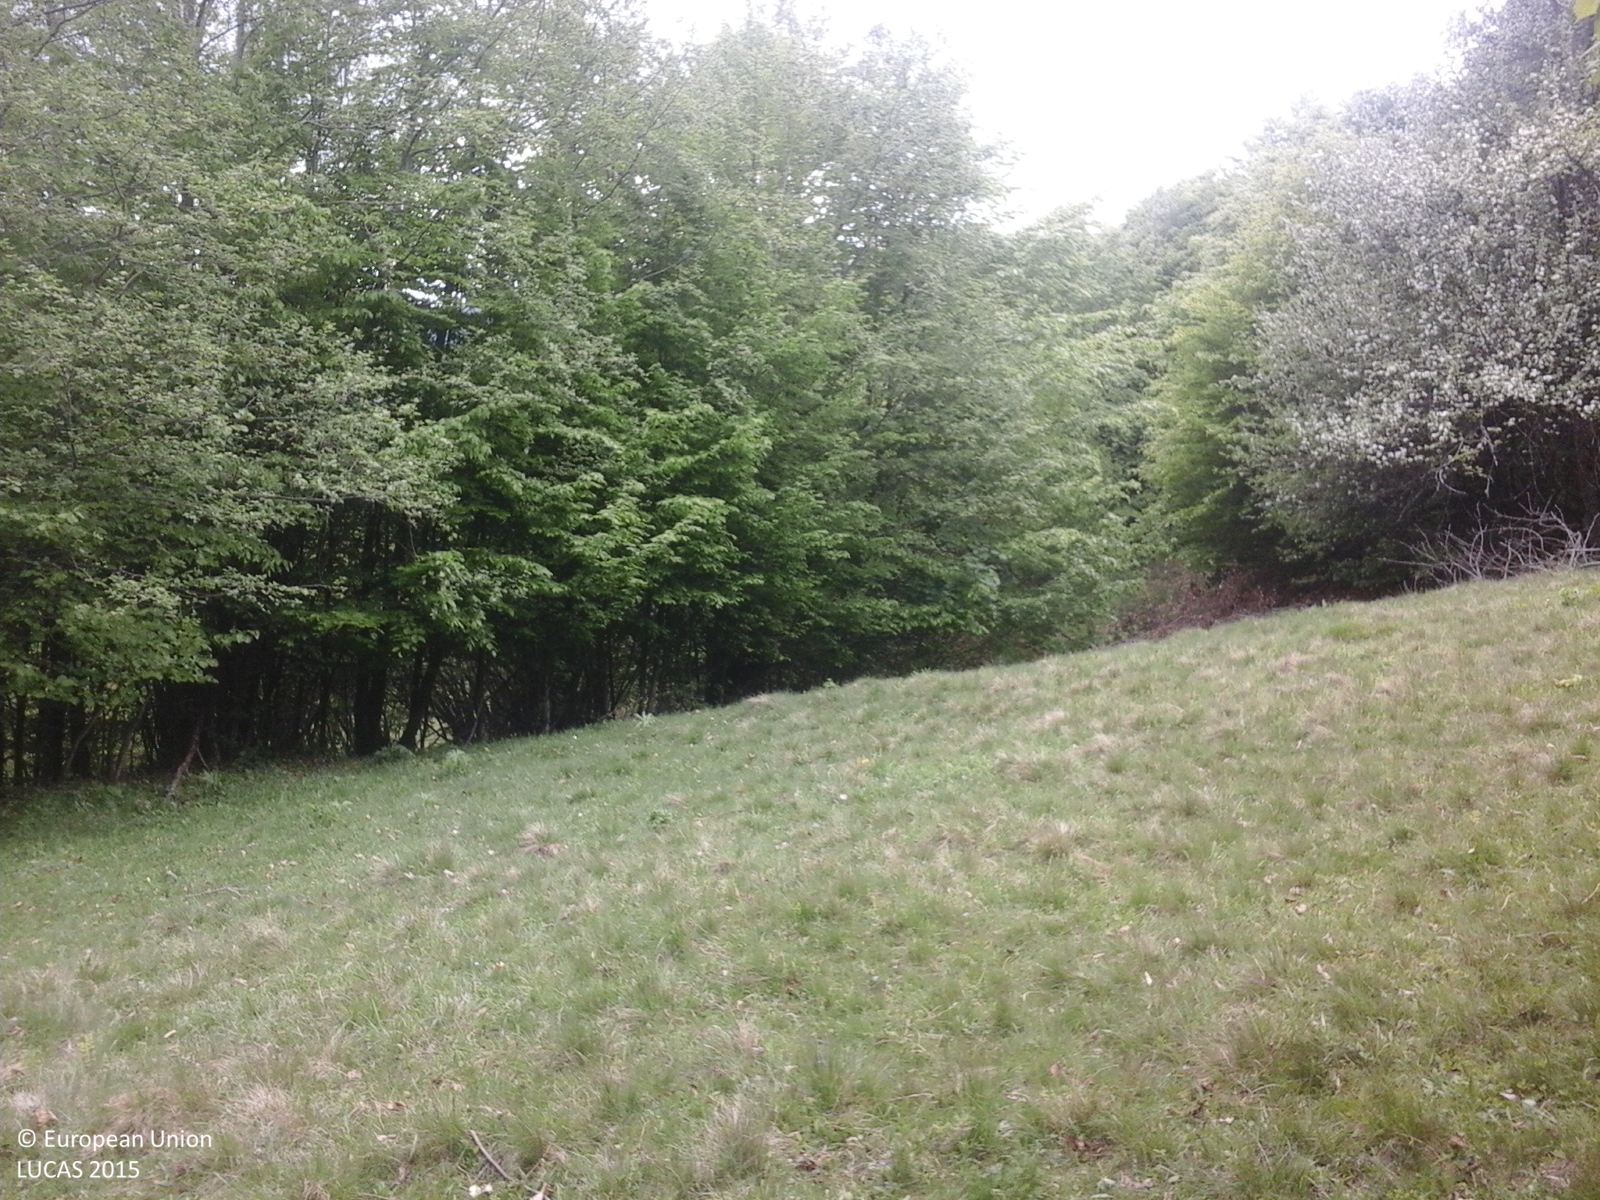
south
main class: Woodland
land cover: Broadleaved woodland
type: beech forest
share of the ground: > 75 %
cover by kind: broadleaved forest trees 100 %
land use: Forestry
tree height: > 5 m
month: May
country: RO
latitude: 45.5900
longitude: 25.9162
